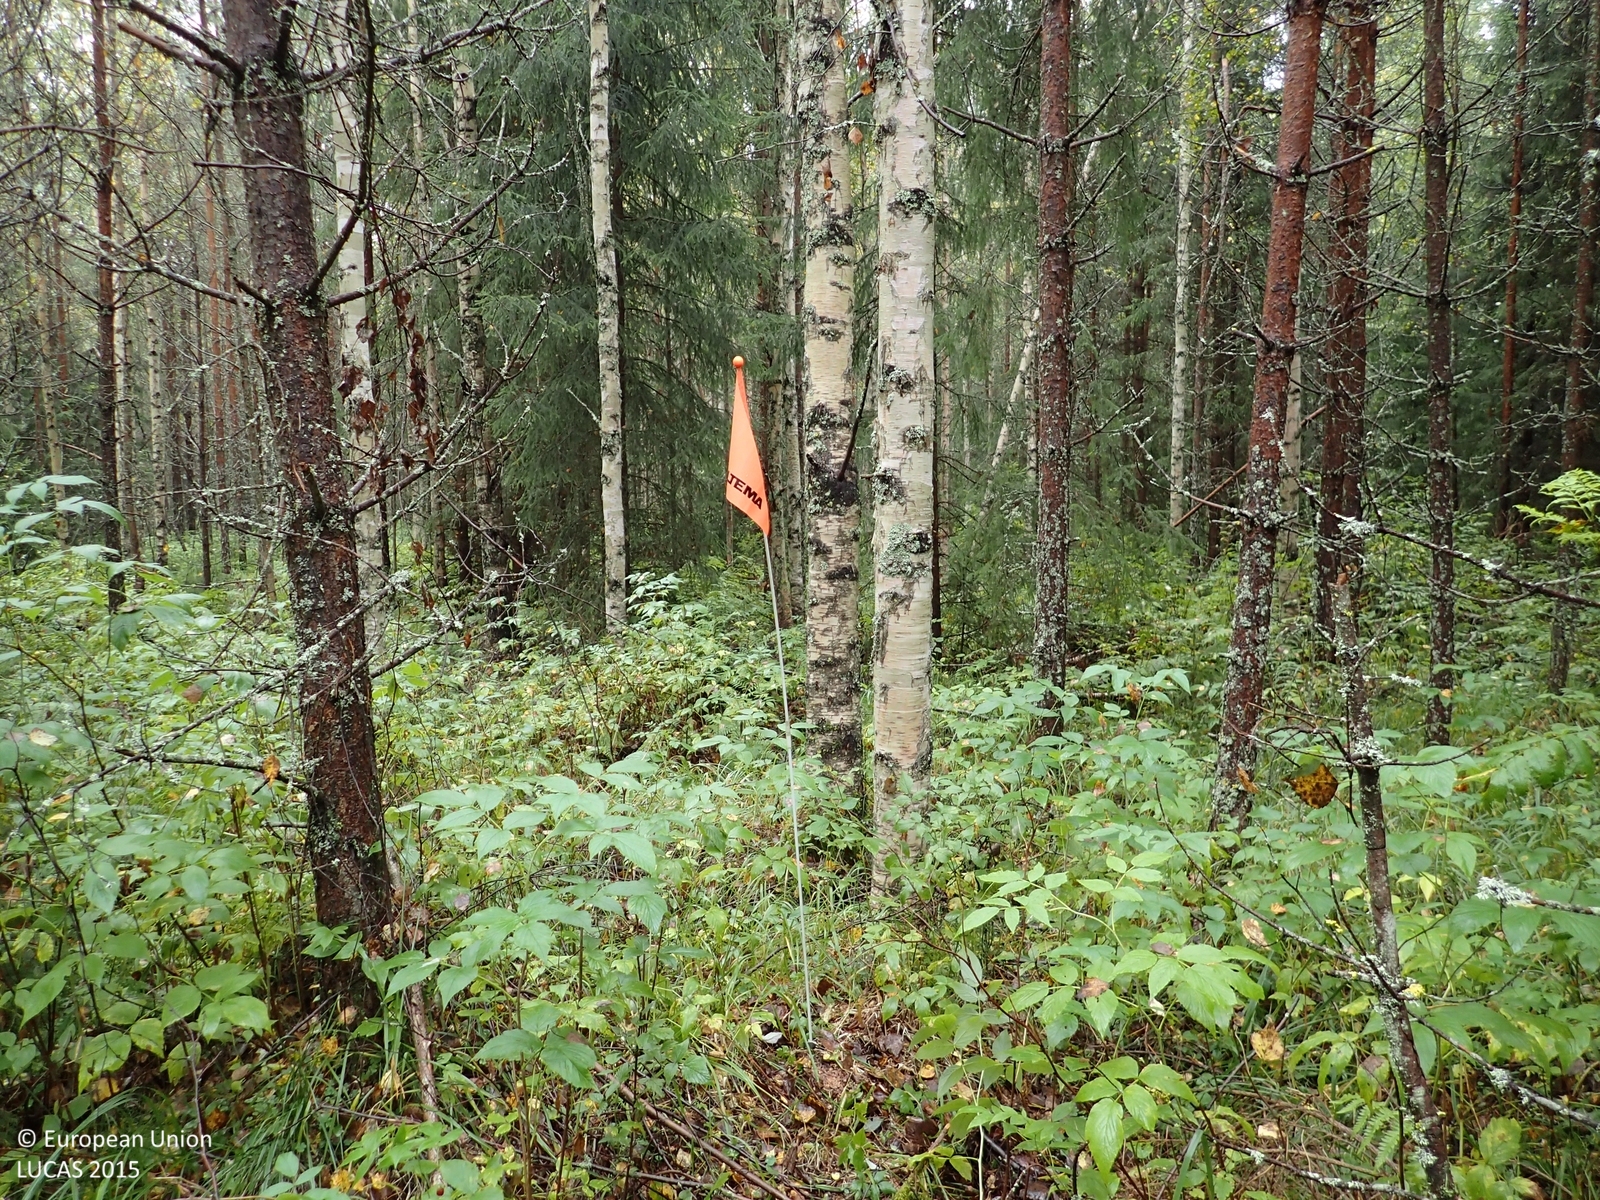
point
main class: Woodland
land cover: Other mixed woodland
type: boreal forest
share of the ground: > 75 %
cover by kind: coniferous forest trees 55 %, broadleaved forest trees 20 %, herbaceous plants 20 %, lichens and mosses 5 %
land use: Forestry
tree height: > 5 m
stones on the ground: < 10 %
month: September
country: FI
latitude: 63.1190
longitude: 25.7936
